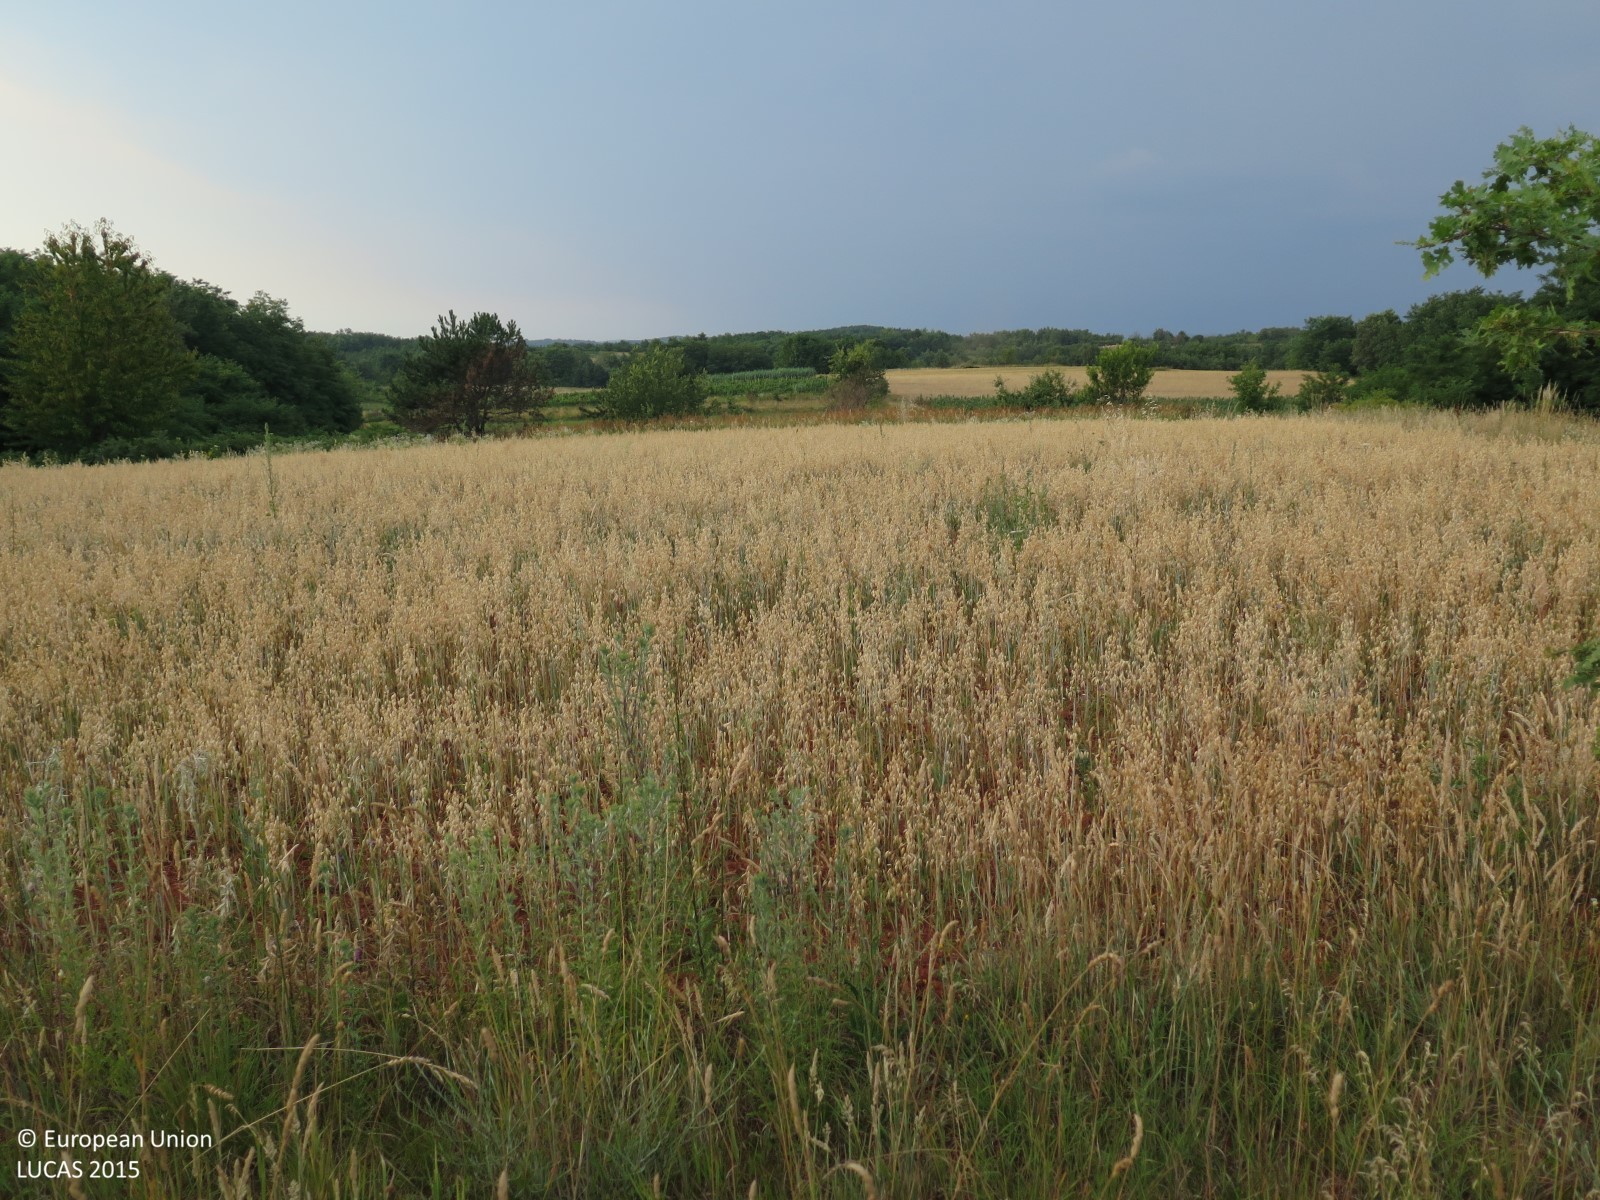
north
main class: Grassland
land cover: Grassland without tree/shrub cover
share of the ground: > 75 %
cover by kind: herbaceous plants 100 %
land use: Agriculture (excluding fallow land and kitchen gardens)
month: July
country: HR
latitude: 45.2545
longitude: 13.8303
